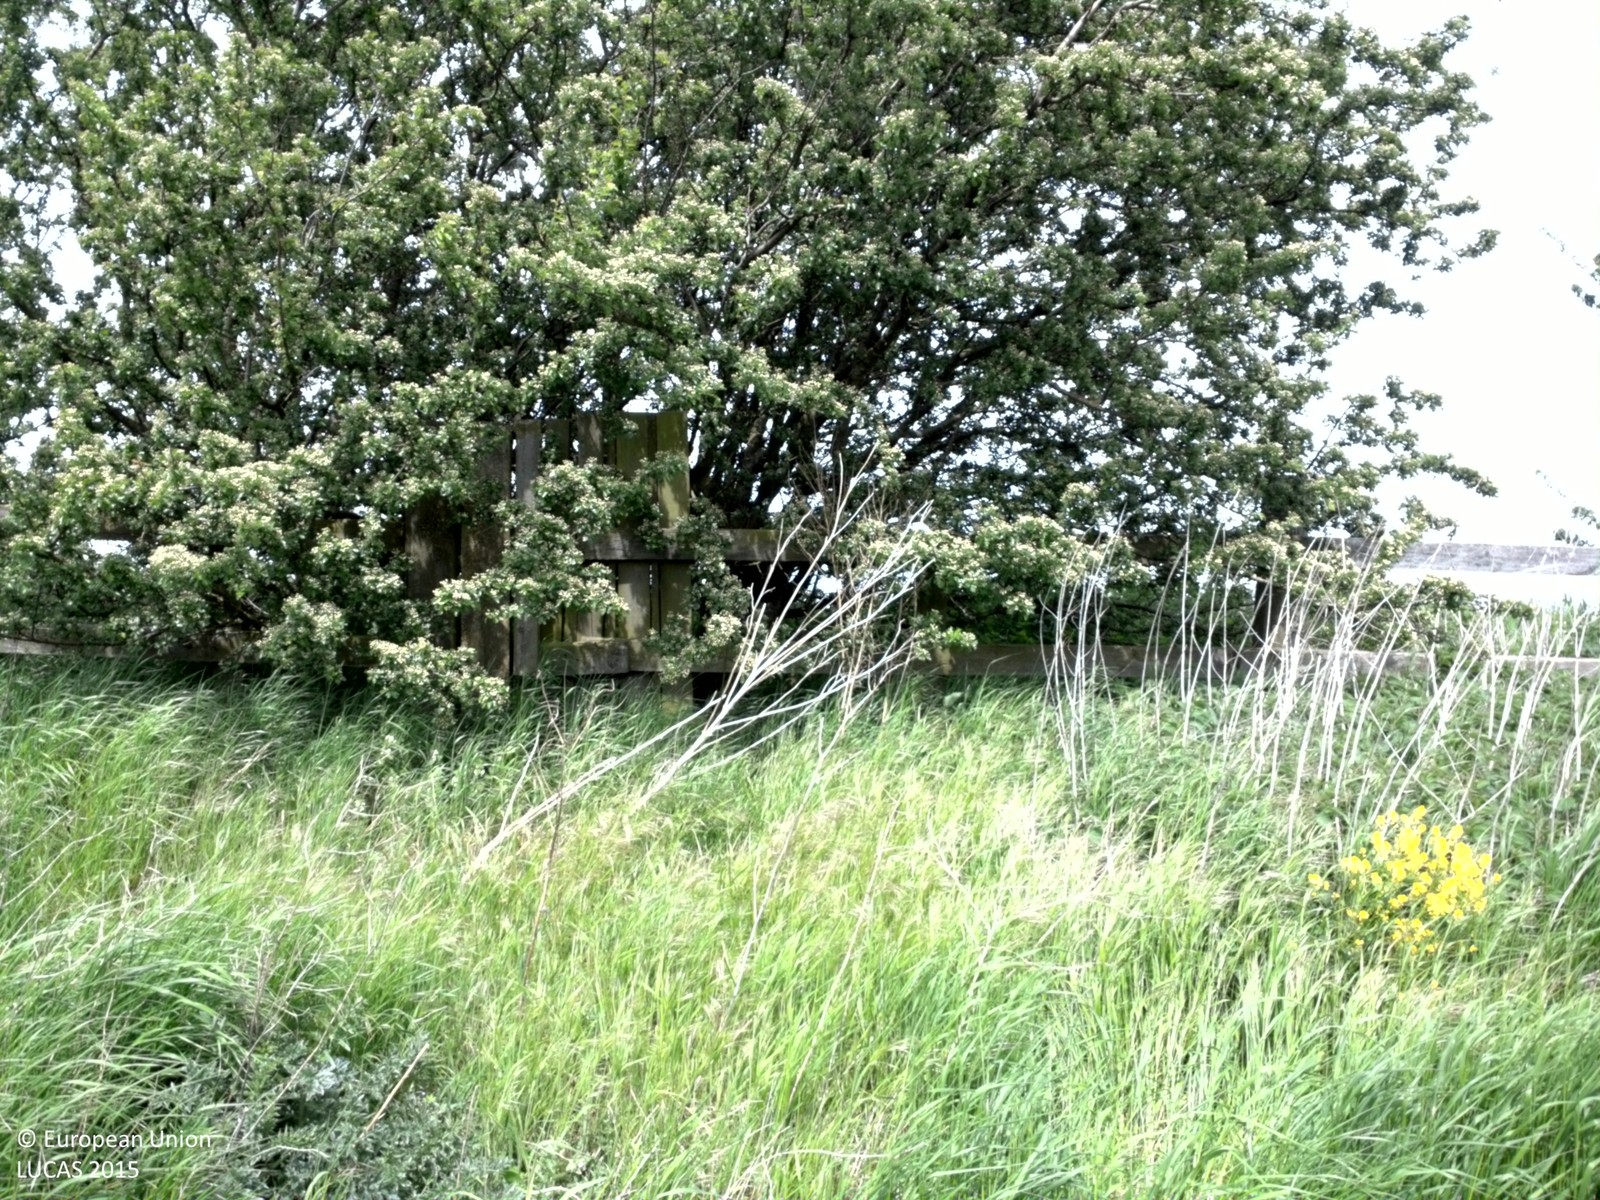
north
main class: Cropland
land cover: Barley
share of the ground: > 75 %
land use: Agriculture (excluding fallow land and kitchen gardens)
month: May
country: SE
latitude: 55.6475
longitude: 13.0648
